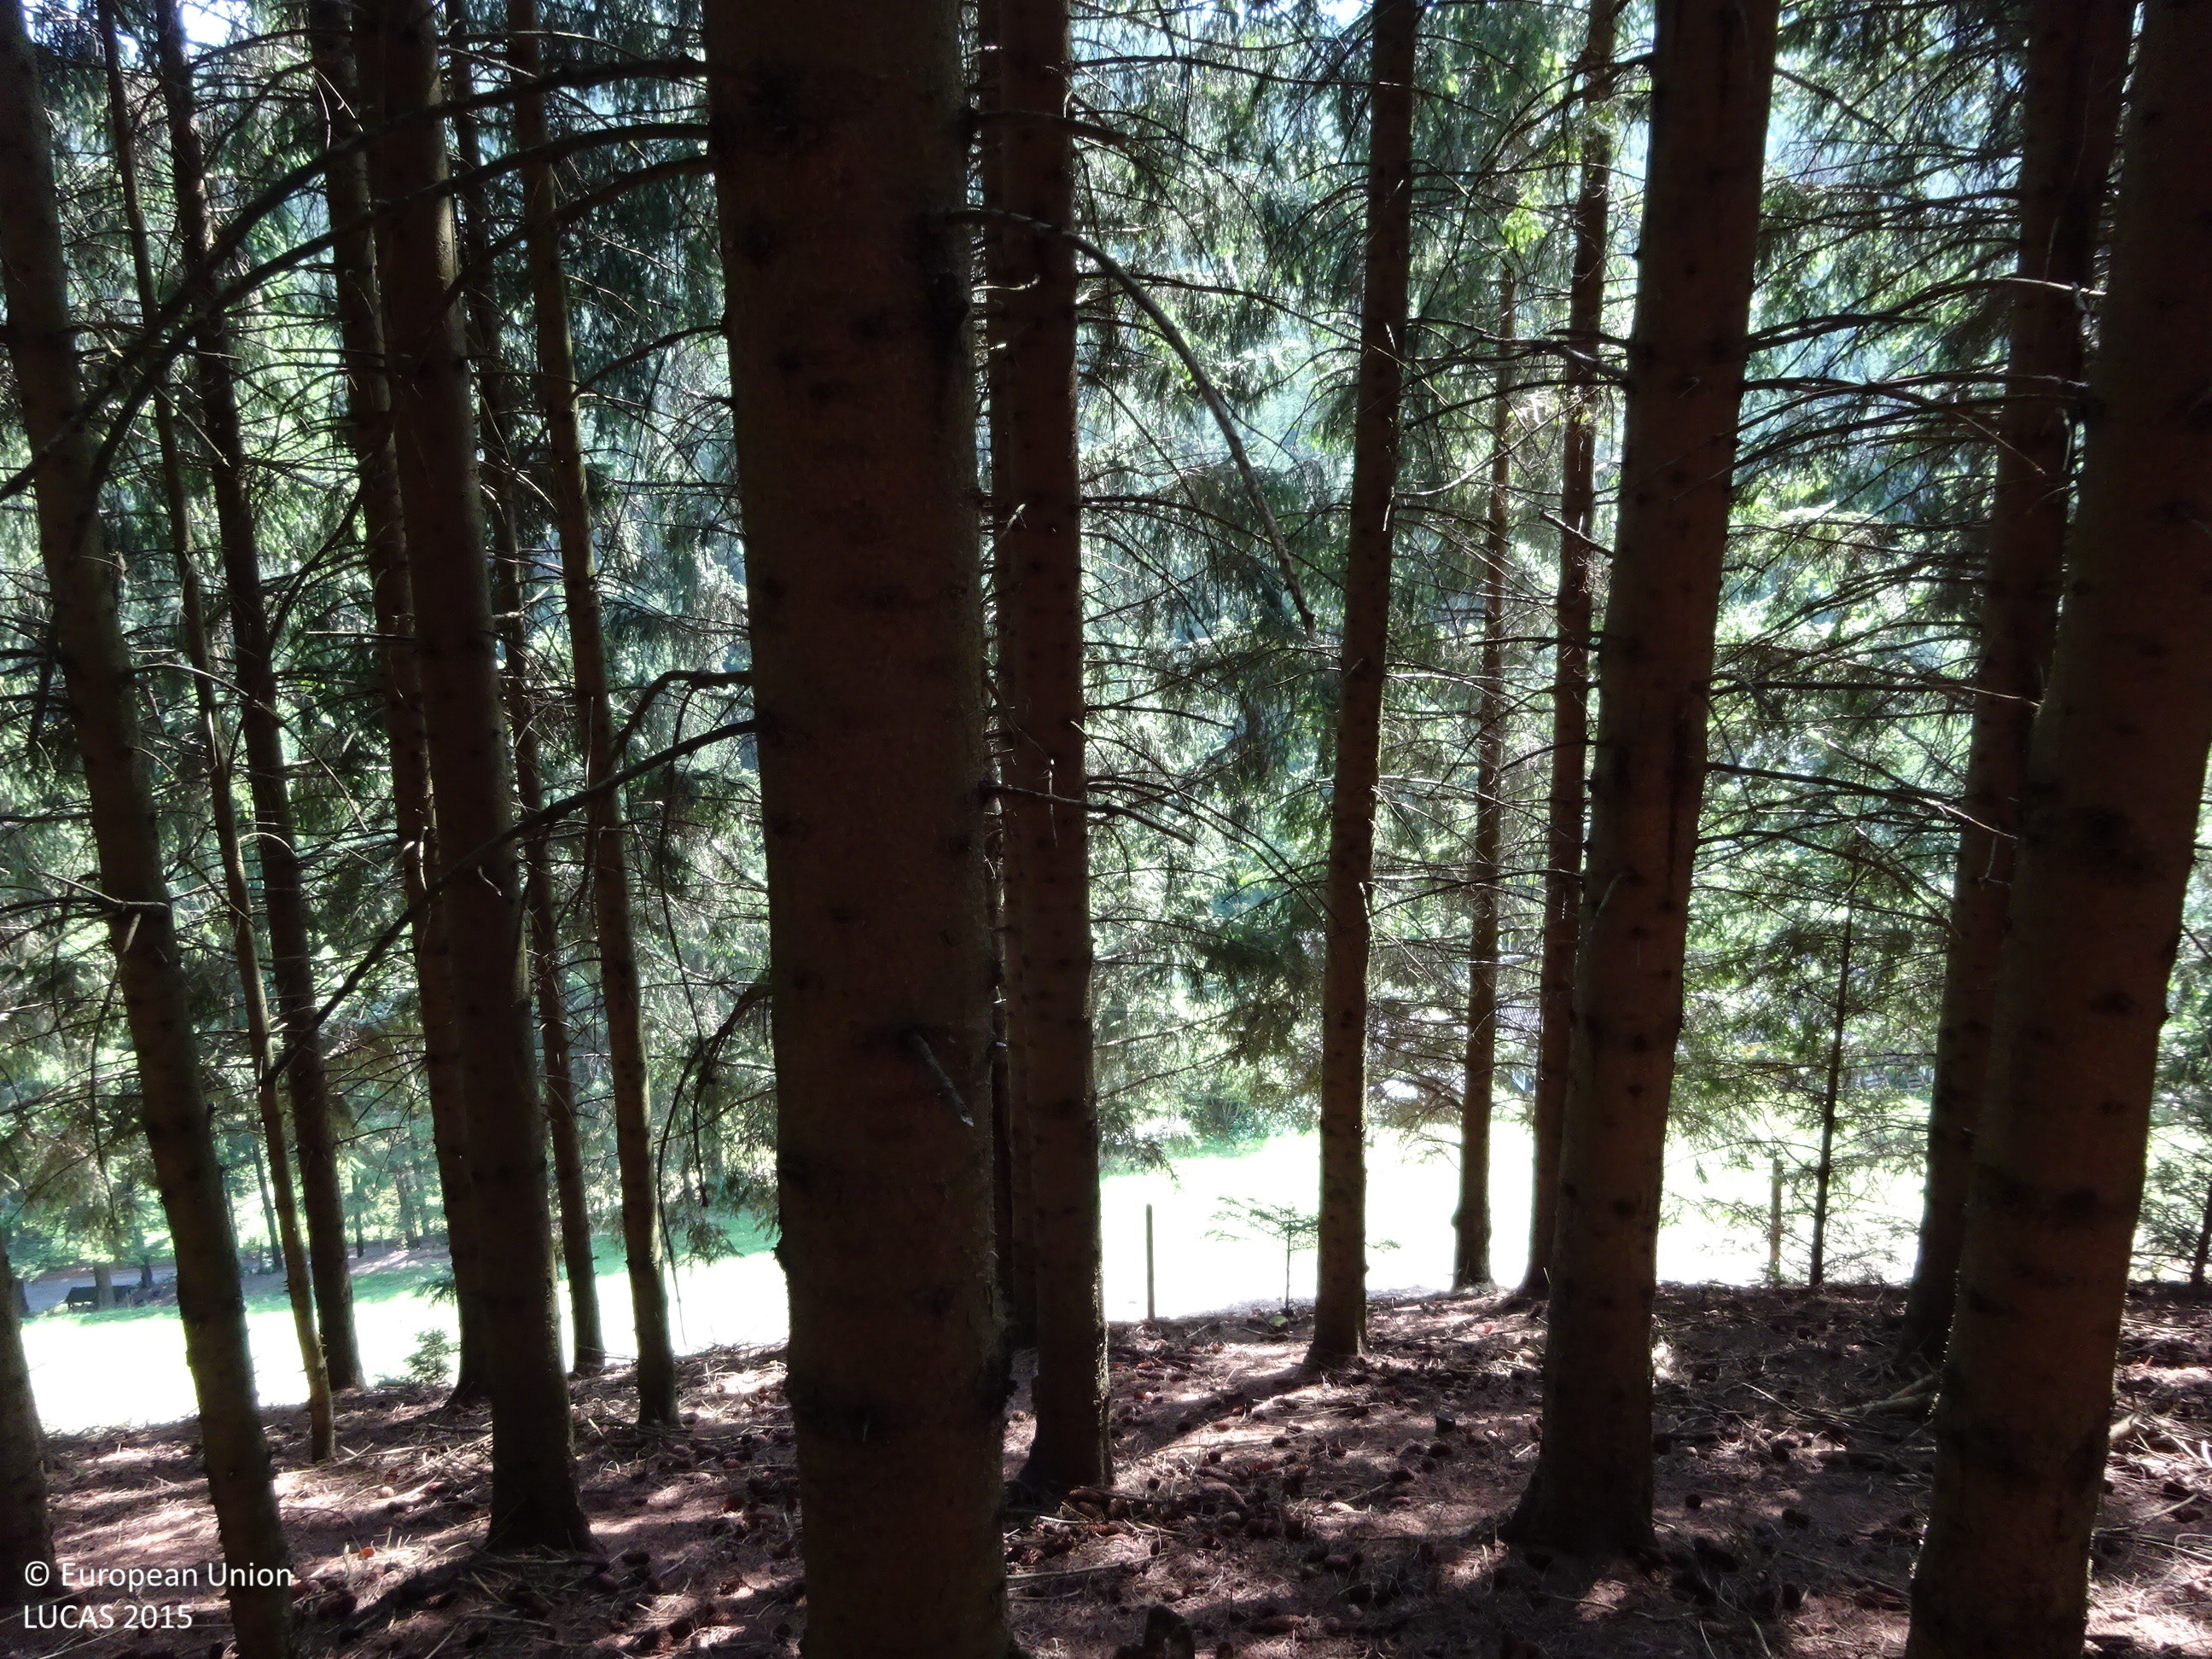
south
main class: Woodland
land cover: Spruce dominated coniferous woodland
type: alpine coniferous forest
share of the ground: > 75 %
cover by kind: coniferous forest trees 100 %
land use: Forestry
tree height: > 5 m
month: August
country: AT
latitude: 47.4589
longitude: 15.7717
